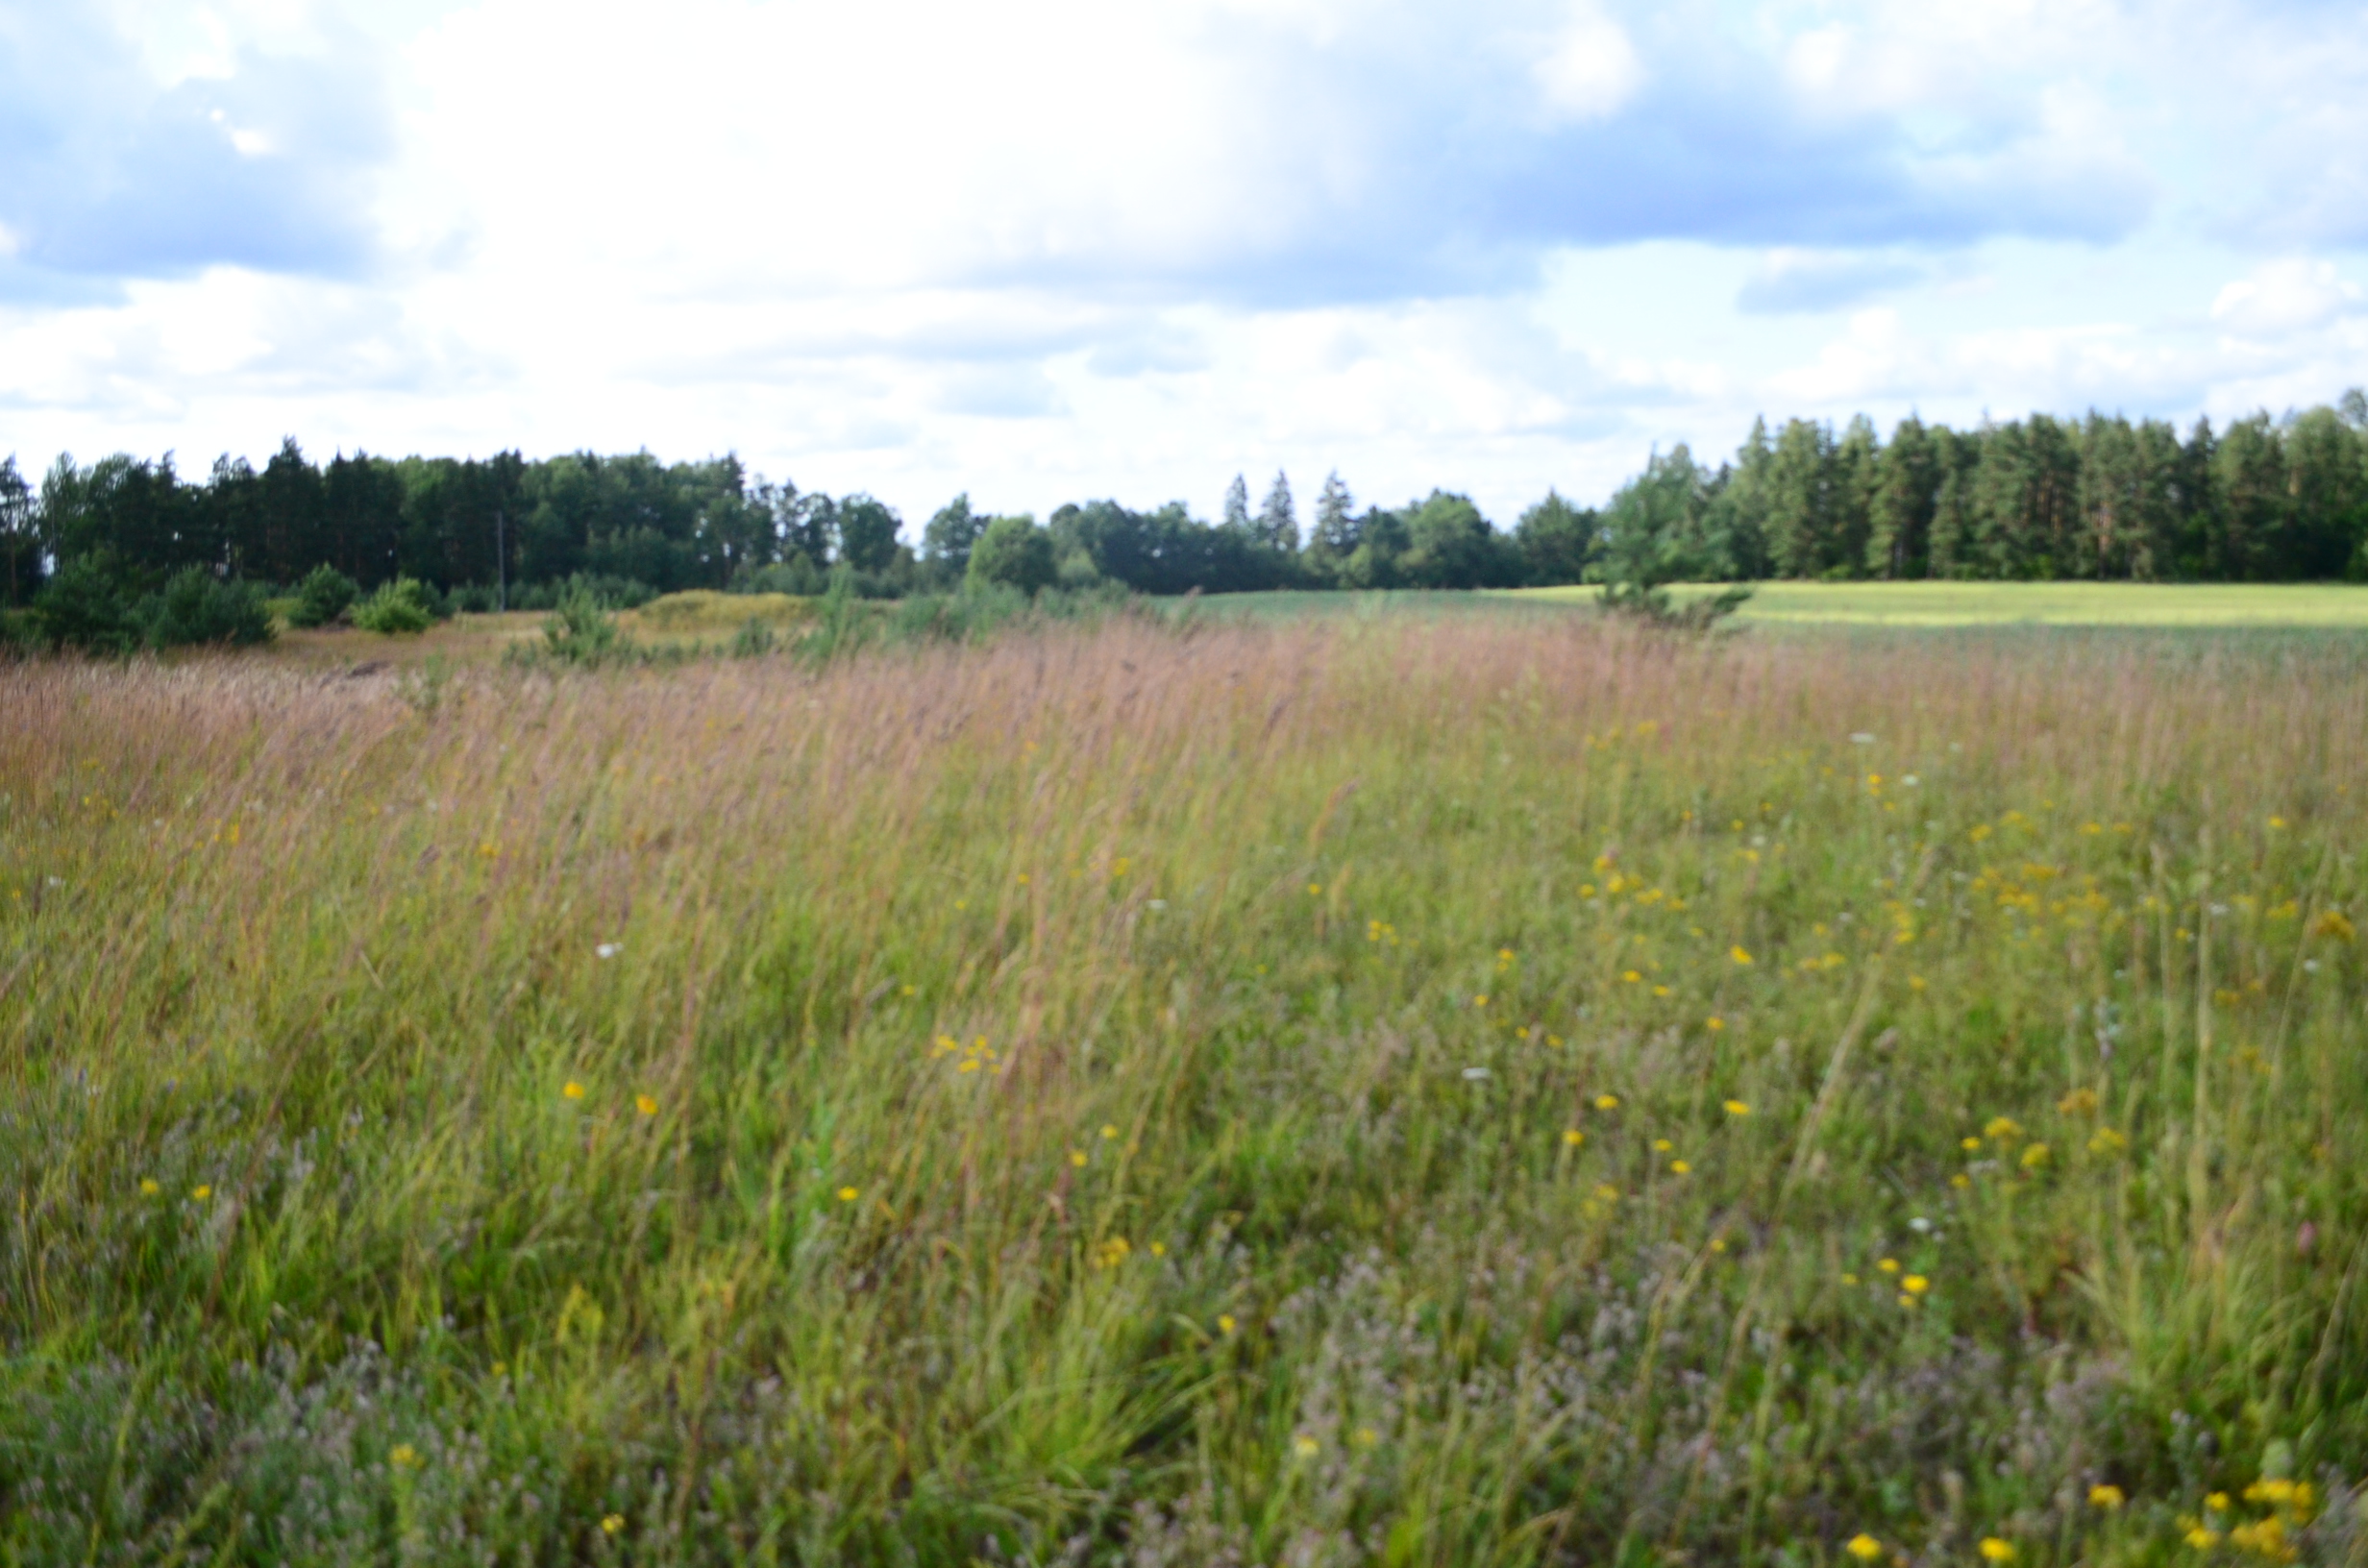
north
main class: Grassland
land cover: Grassland without tree/shrub cover
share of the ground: > 75 %
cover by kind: herbaceous plants 100 %
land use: Agriculture (excluding fallow land and kitchen gardens)
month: July
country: LV
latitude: 57.0703
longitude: 22.4742
